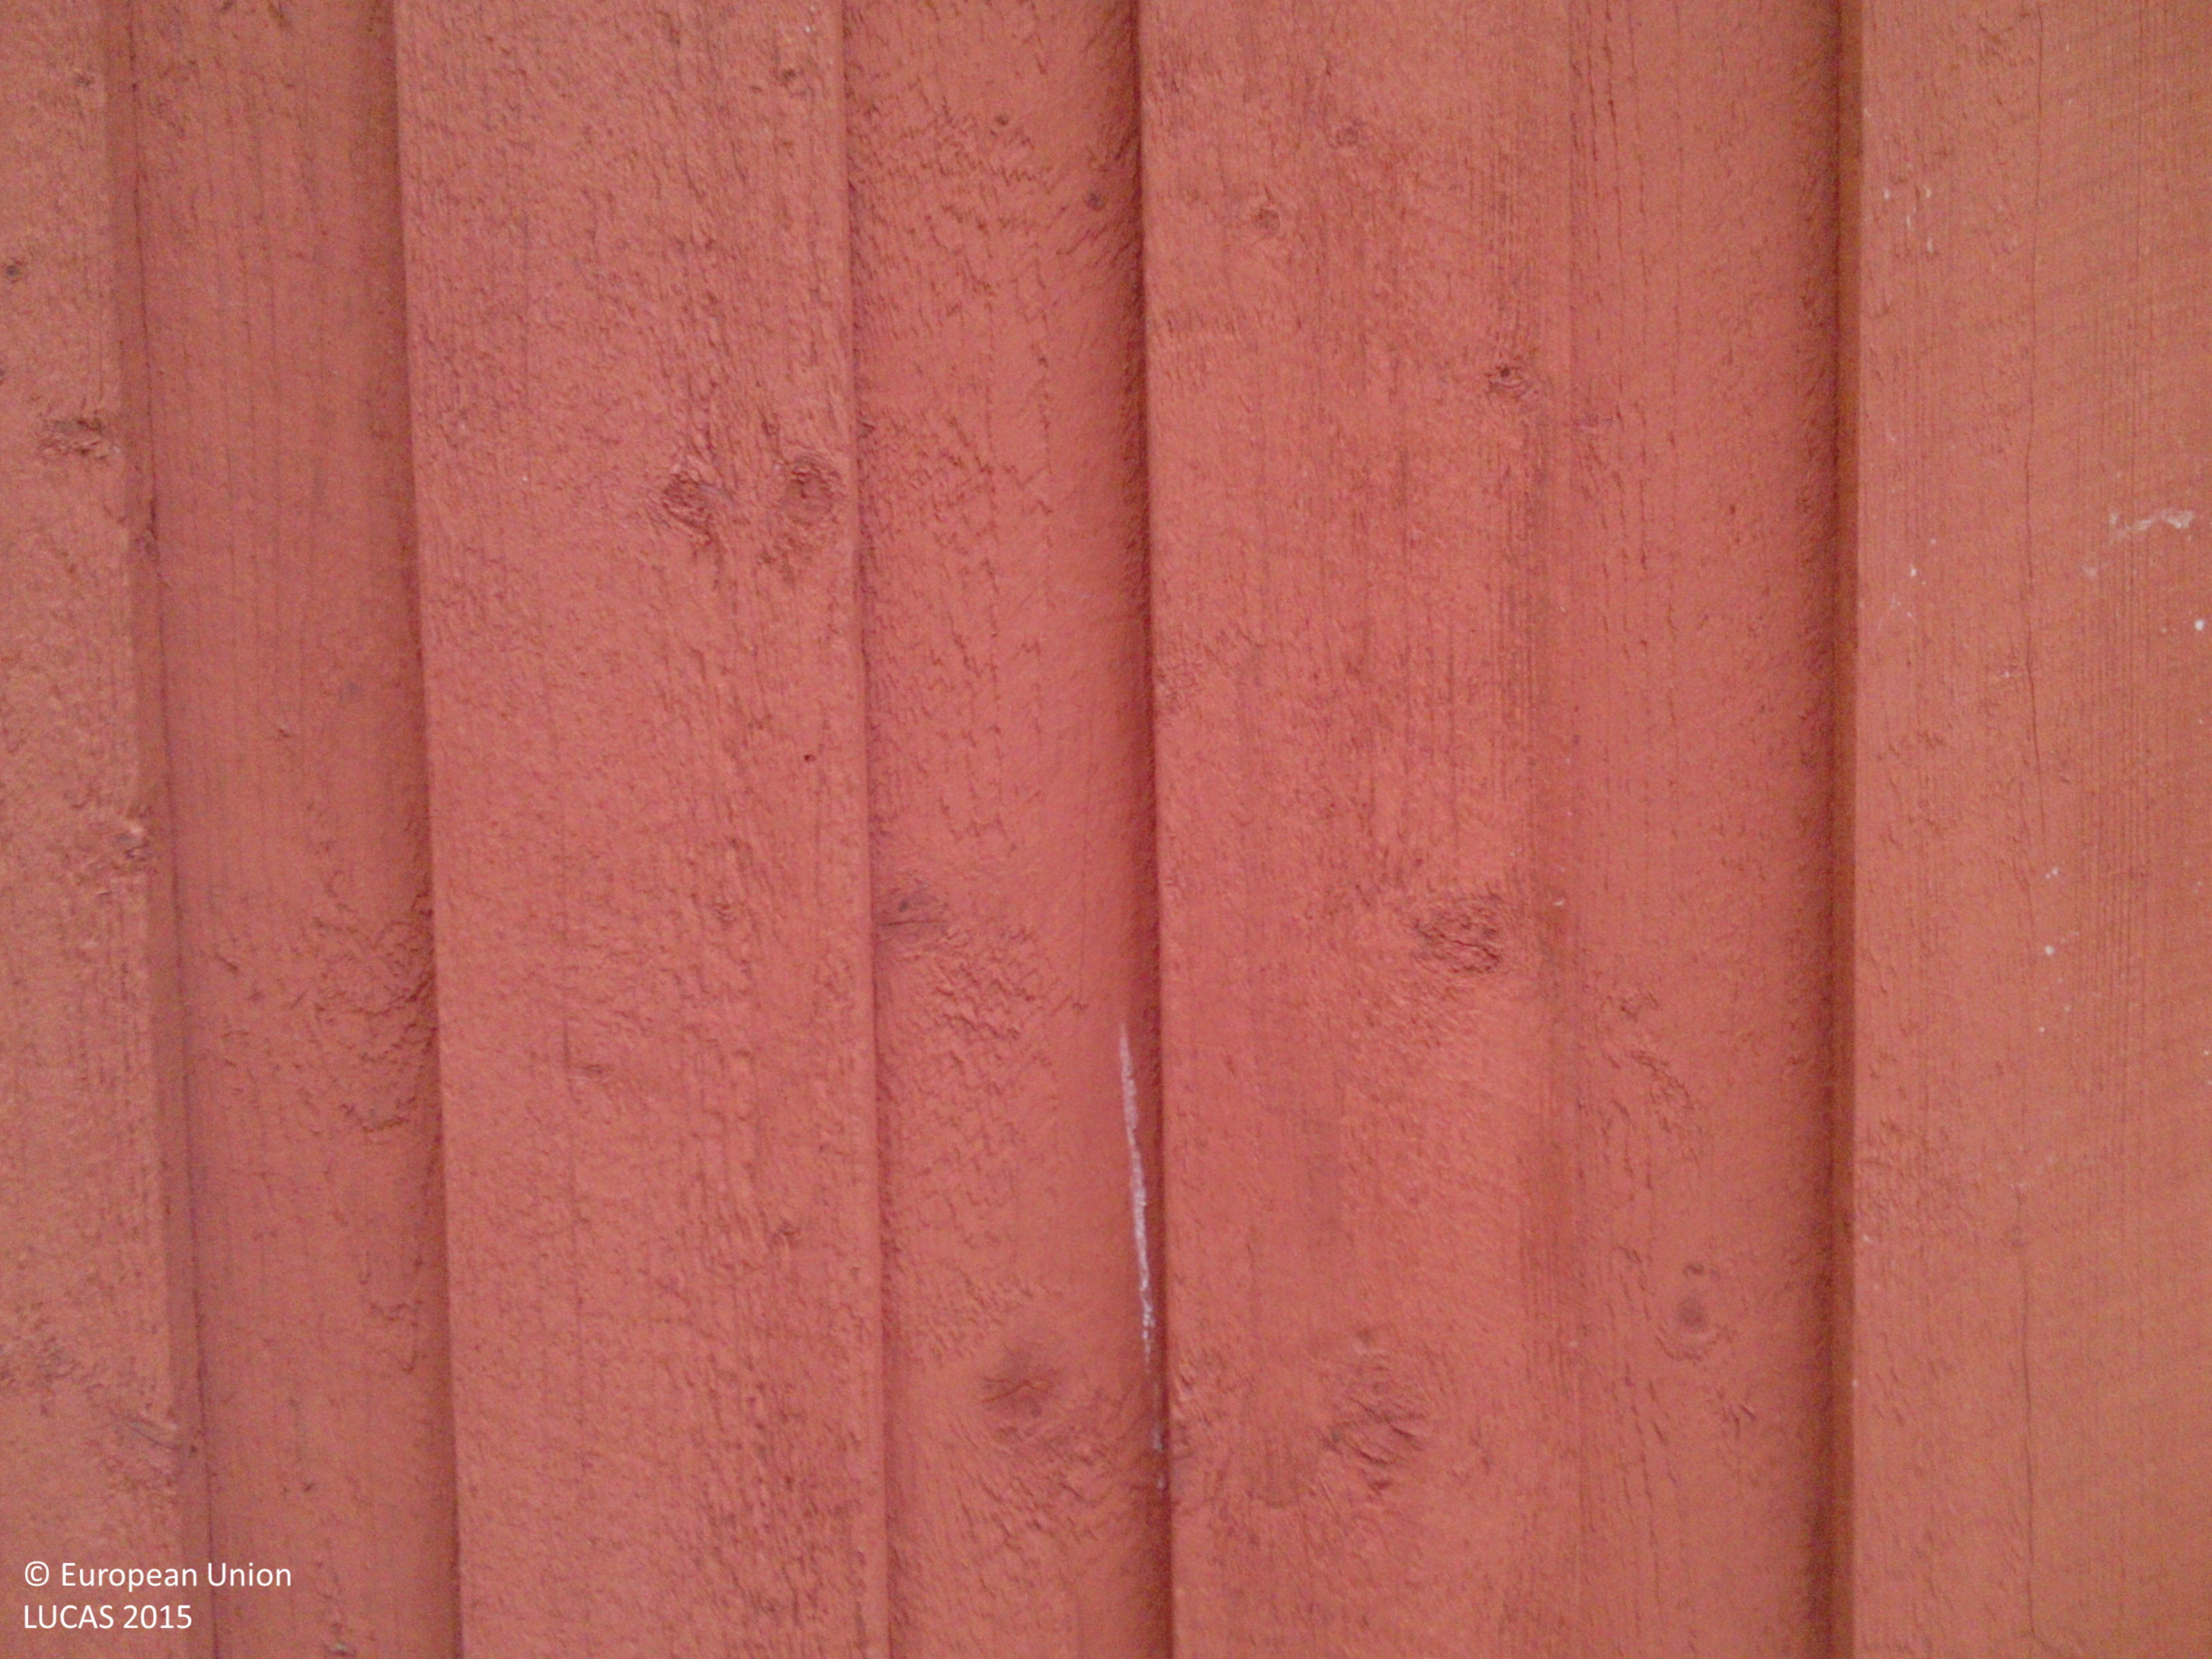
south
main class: Grassland
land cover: Grassland without tree/shrub cover
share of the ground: 50 - 75 %
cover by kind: herbaceous plants 70 %, consolidated bare surface 10 %
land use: Residential
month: October
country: SE
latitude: 59.0457
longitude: 16.3211
